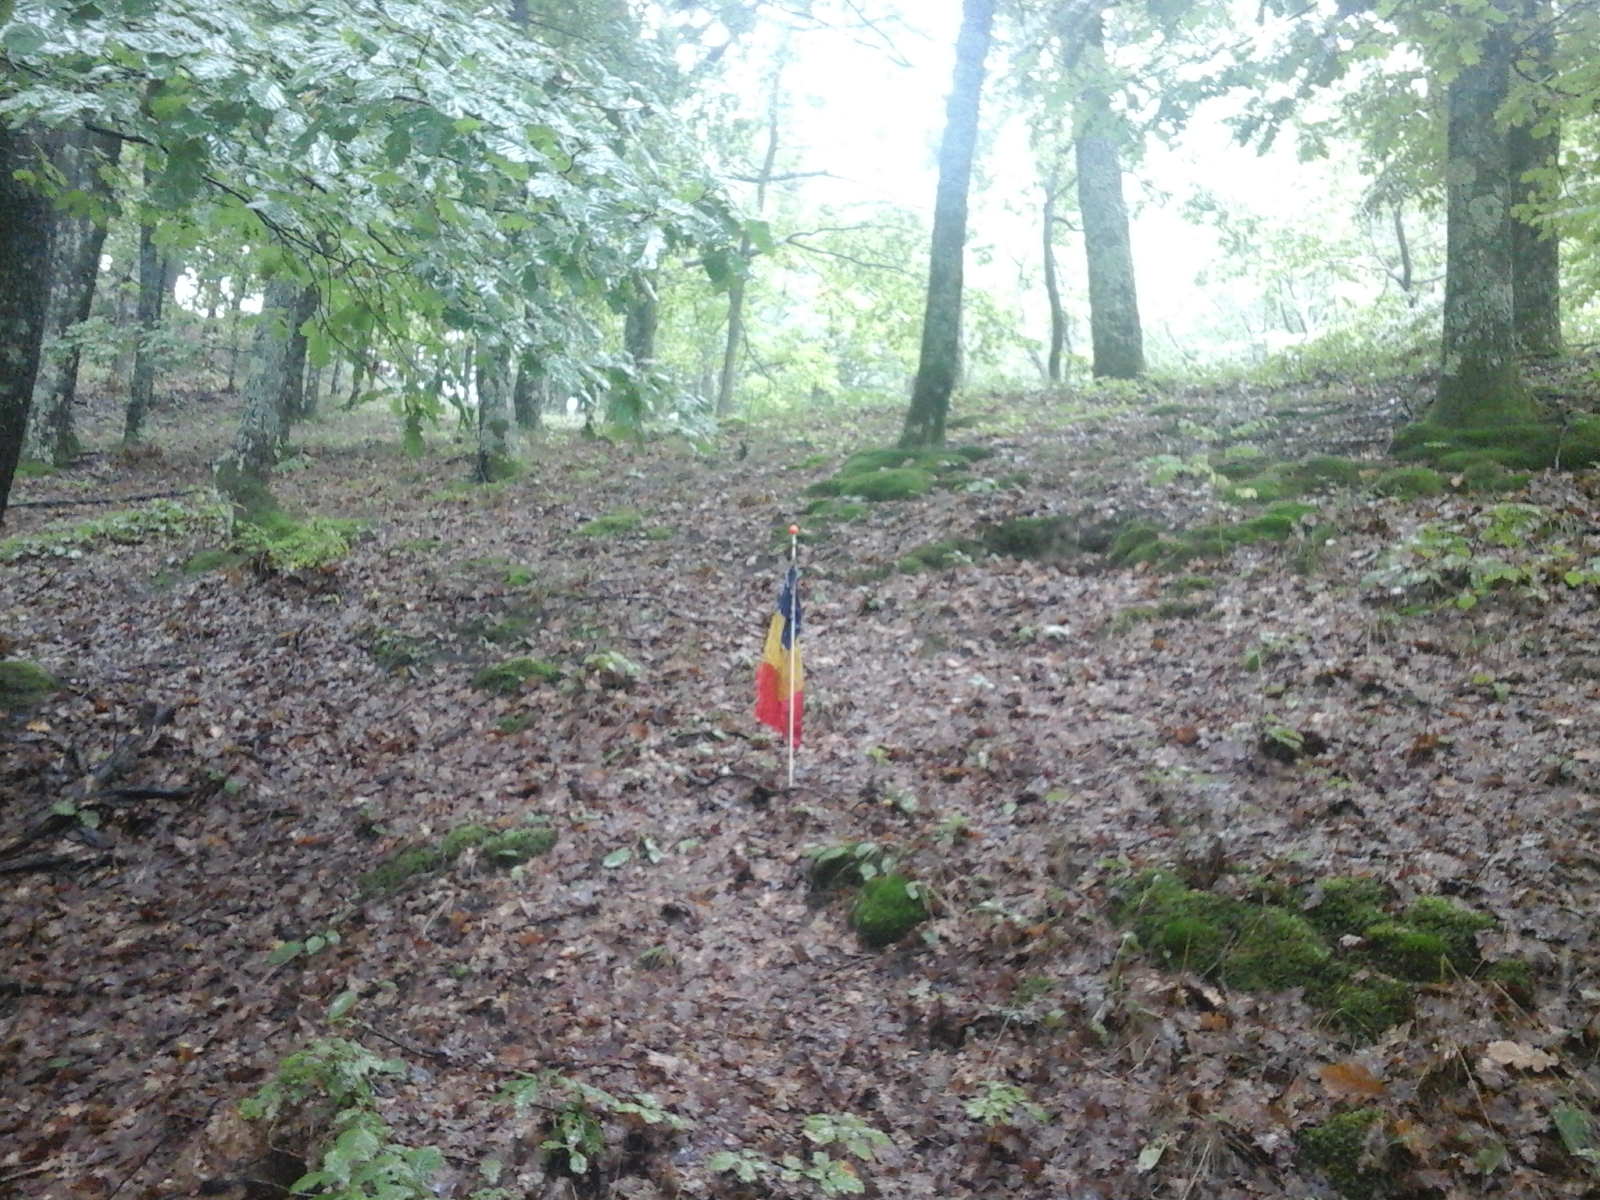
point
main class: Woodland
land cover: Broadleaved woodland
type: acidophilous oak and oak-birch forest
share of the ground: > 75 %
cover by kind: broadleaved forest trees 100 %
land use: Forestry
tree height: > 5 m
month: September
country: RO
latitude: 44.9308
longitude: 23.7323
